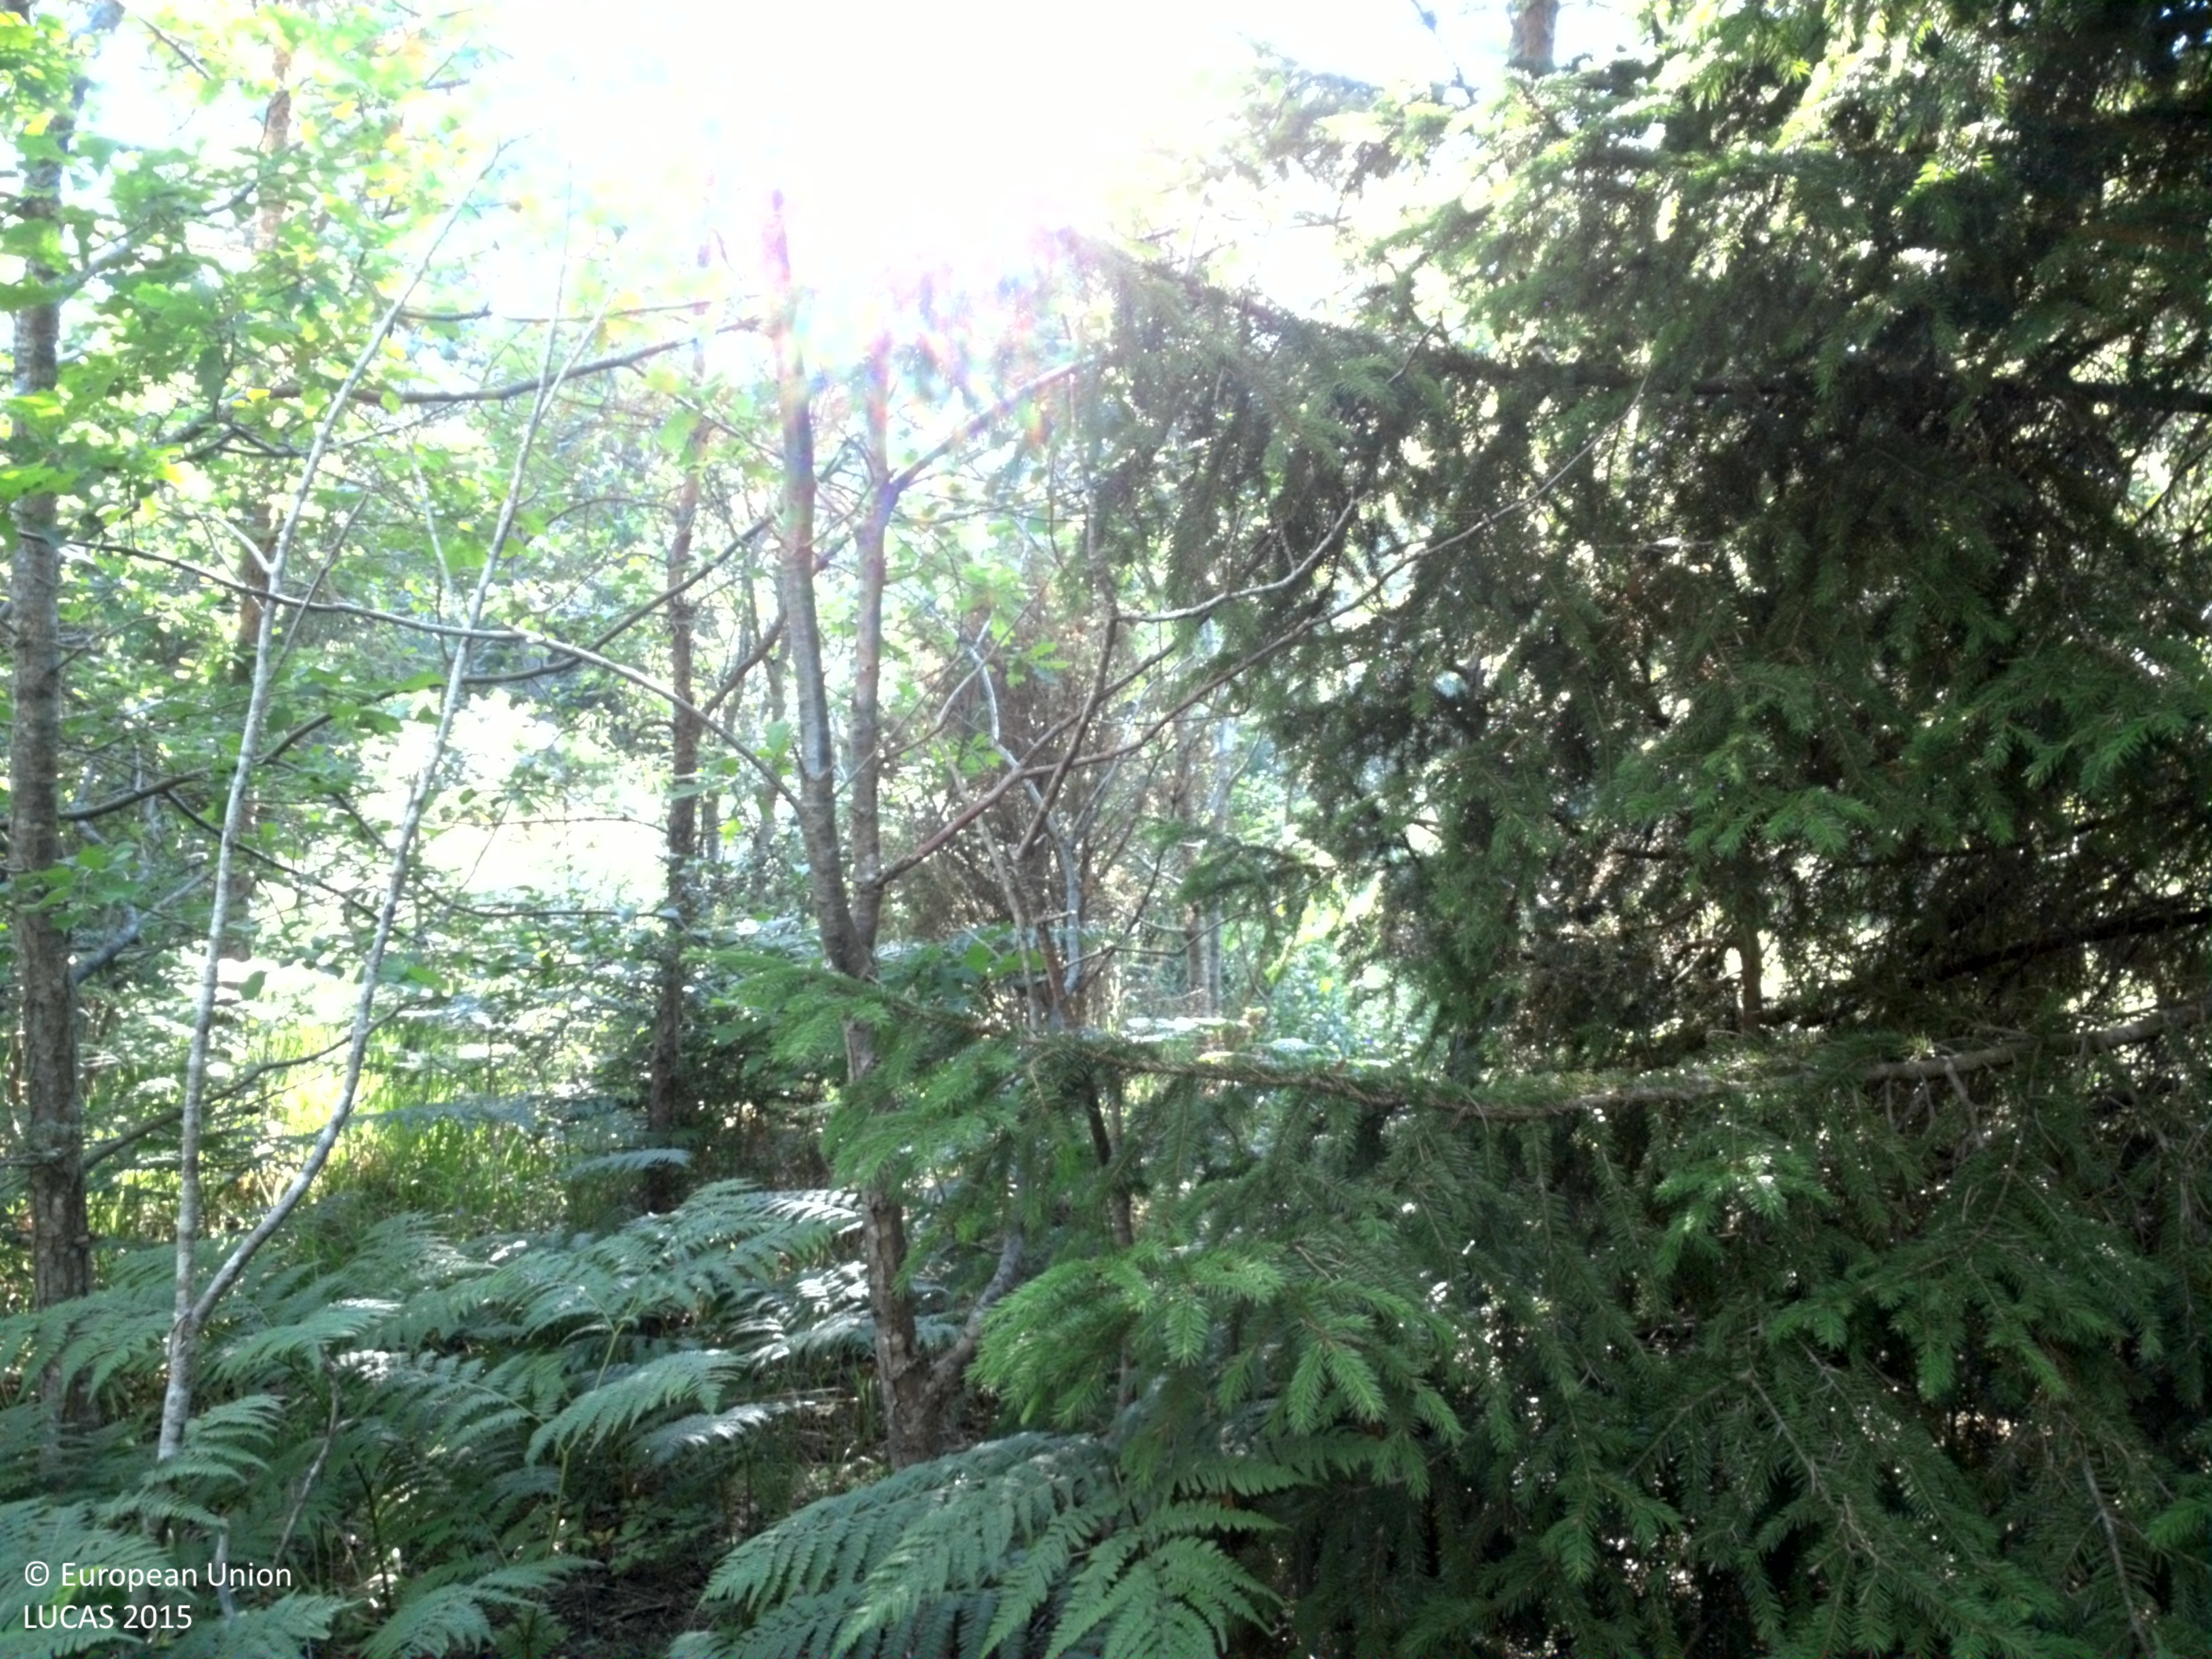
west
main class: Woodland
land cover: Pine dominated mixed woodland
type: hemiboreal forest and nemoral coniferous forest and mixed broadleaved-coniferous forest
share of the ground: > 75 %
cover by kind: coniferous forest trees 45 %, broadleaved forest trees 30 %, shrubs 15 %, herbaceous plants 10 %
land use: Semi-natural and natural areas not in use
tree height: > 5 m
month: July
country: SE
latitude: 57.7653
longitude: 18.8348
